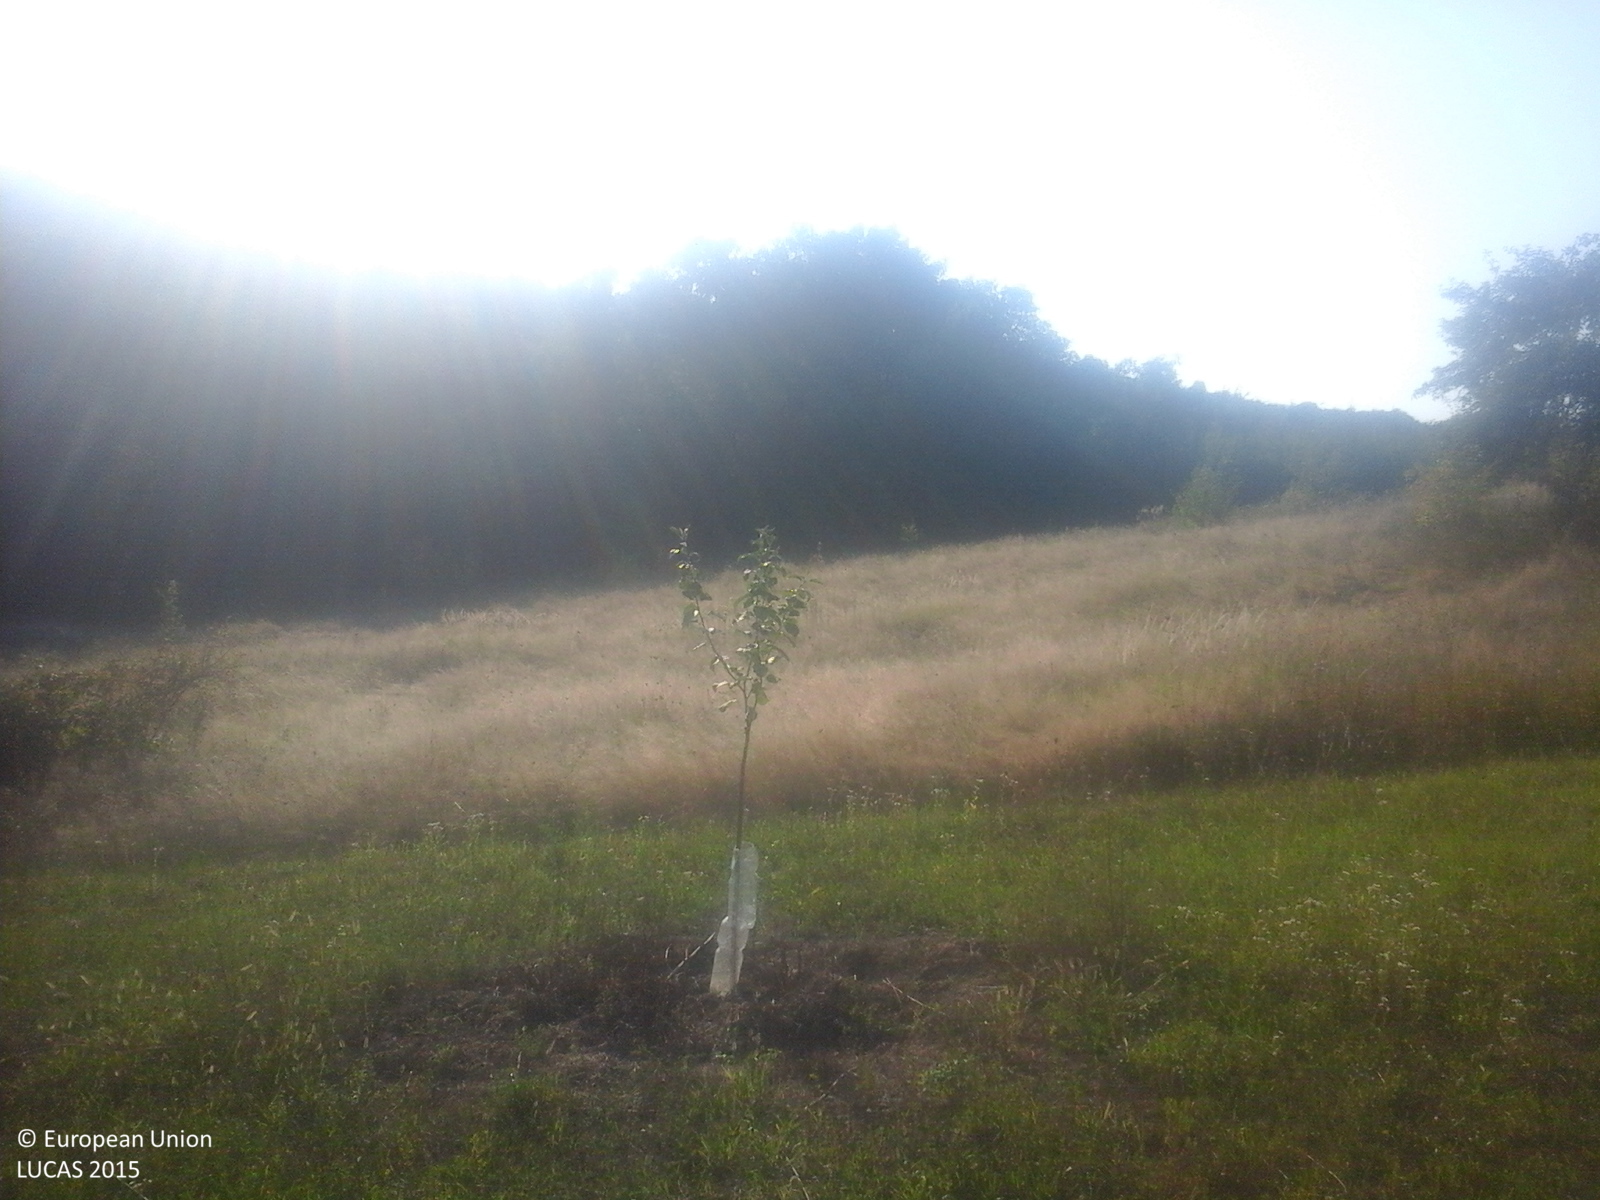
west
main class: Cropland
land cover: Apple fruit
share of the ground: 10 - 25 %
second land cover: Grassland without tree/shrub cover
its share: > 75 %
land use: Agriculture (excluding fallow land and kitchen gardens)
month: September
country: RO
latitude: 46.6172
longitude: 22.3376
